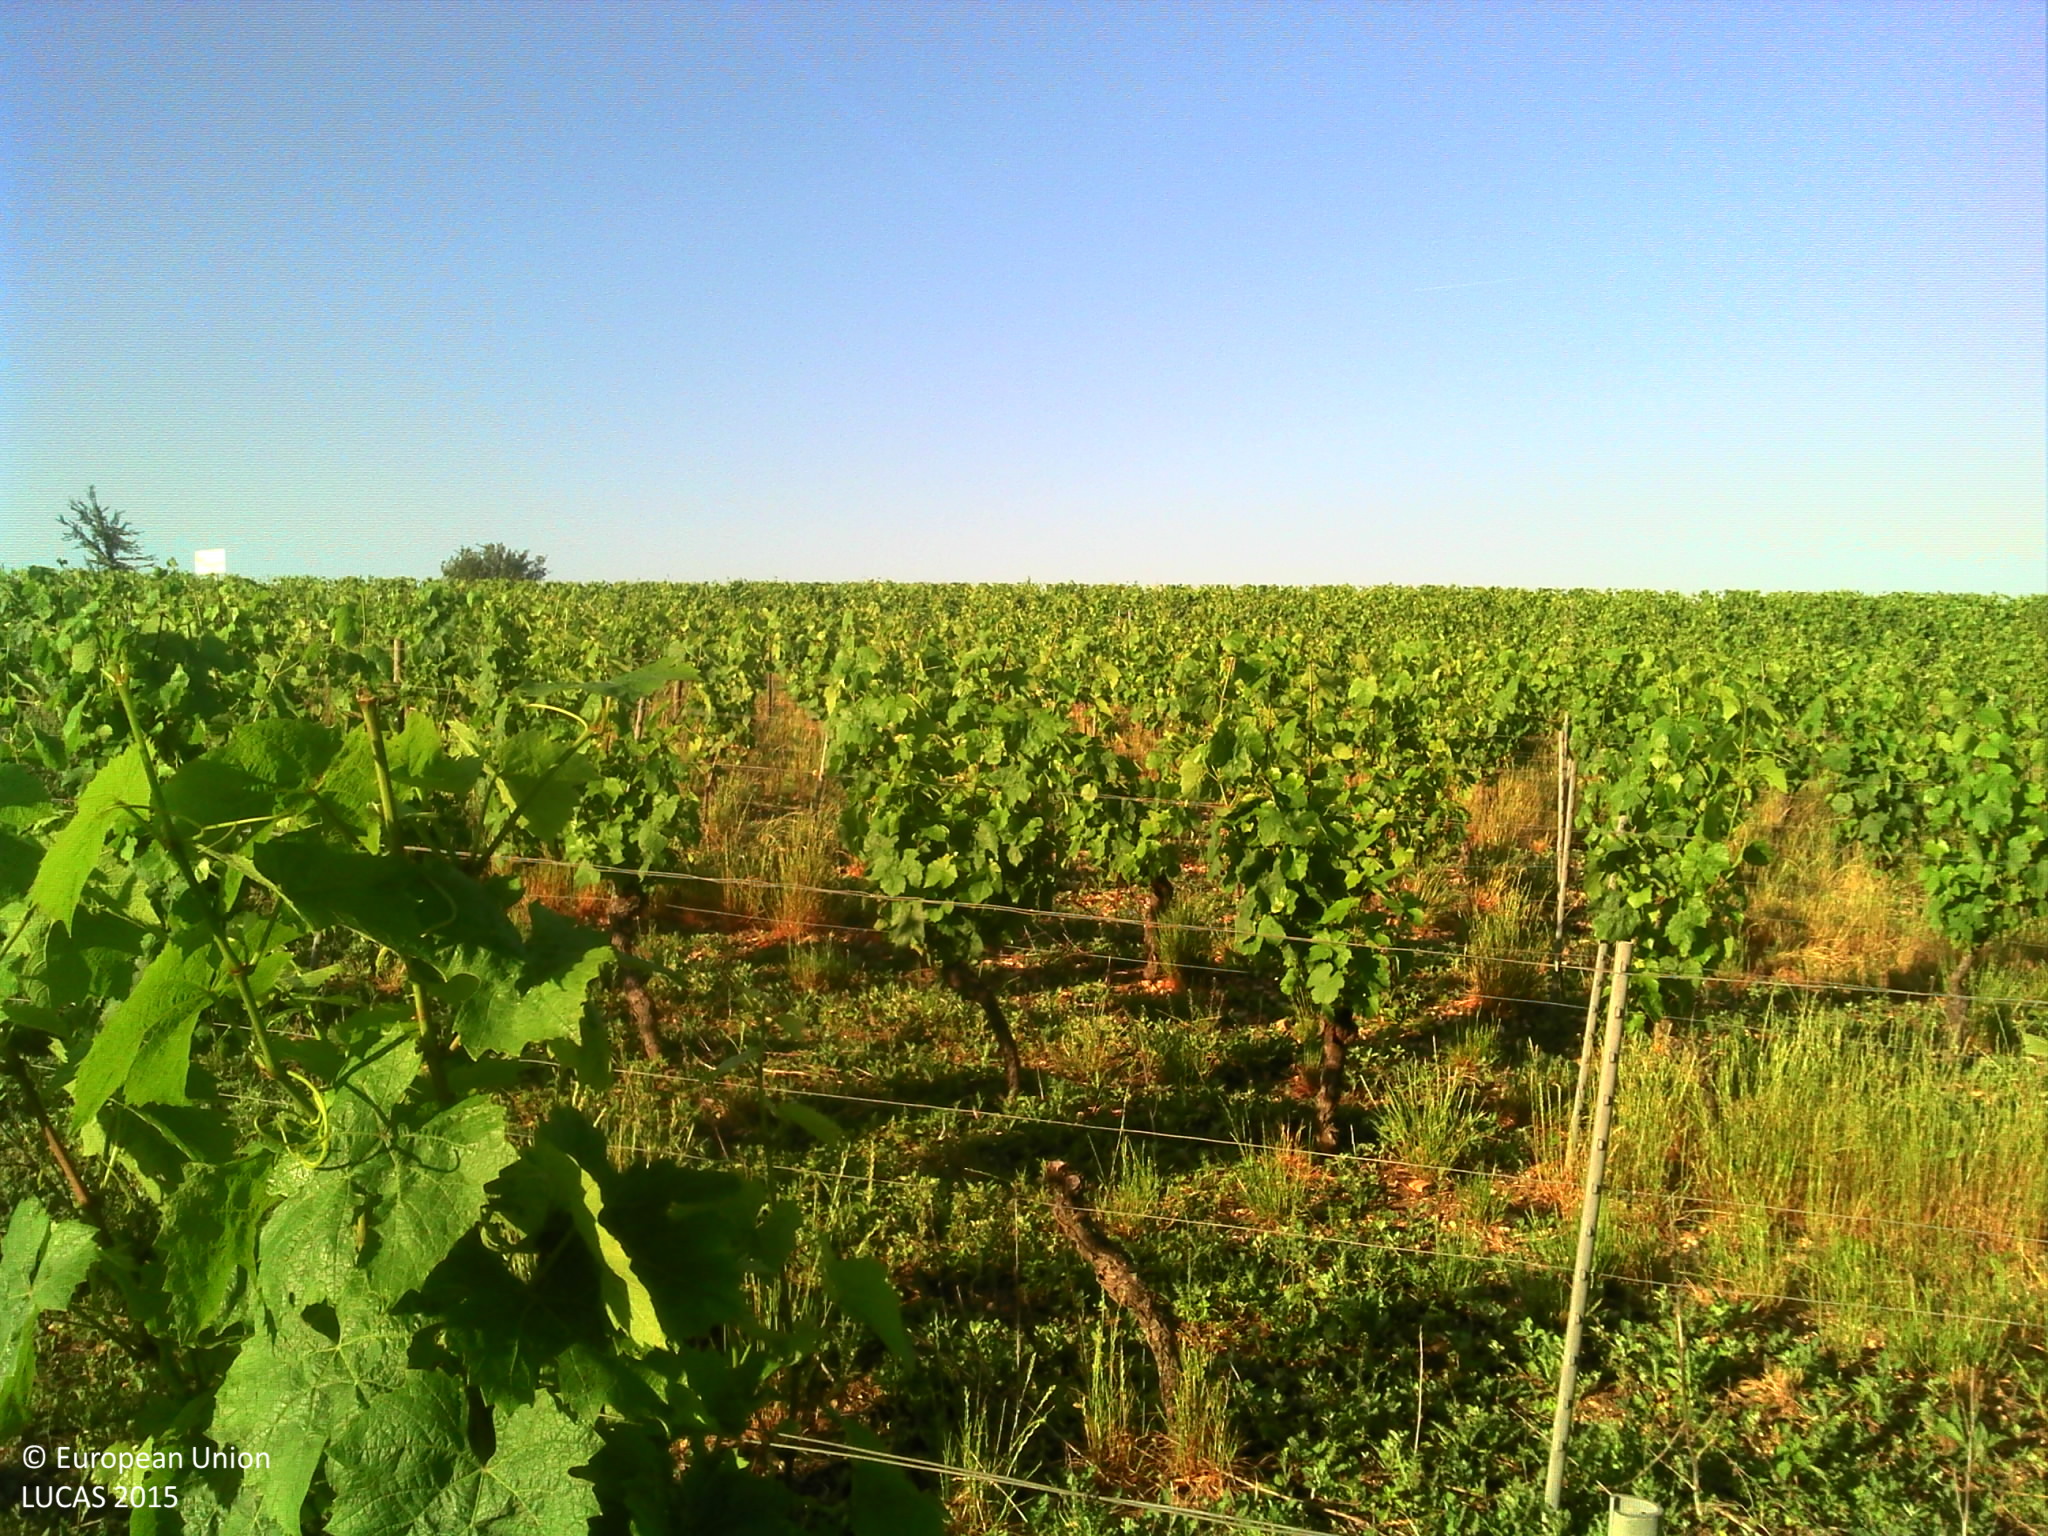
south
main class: Cropland
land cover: Vineyards
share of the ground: 10 - 25 %
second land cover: Spontaneously vegetated surfaces
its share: > 75 %
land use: Agriculture (excluding fallow land and kitchen gardens)
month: June
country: FR
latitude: 44.0179
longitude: 1.9315
